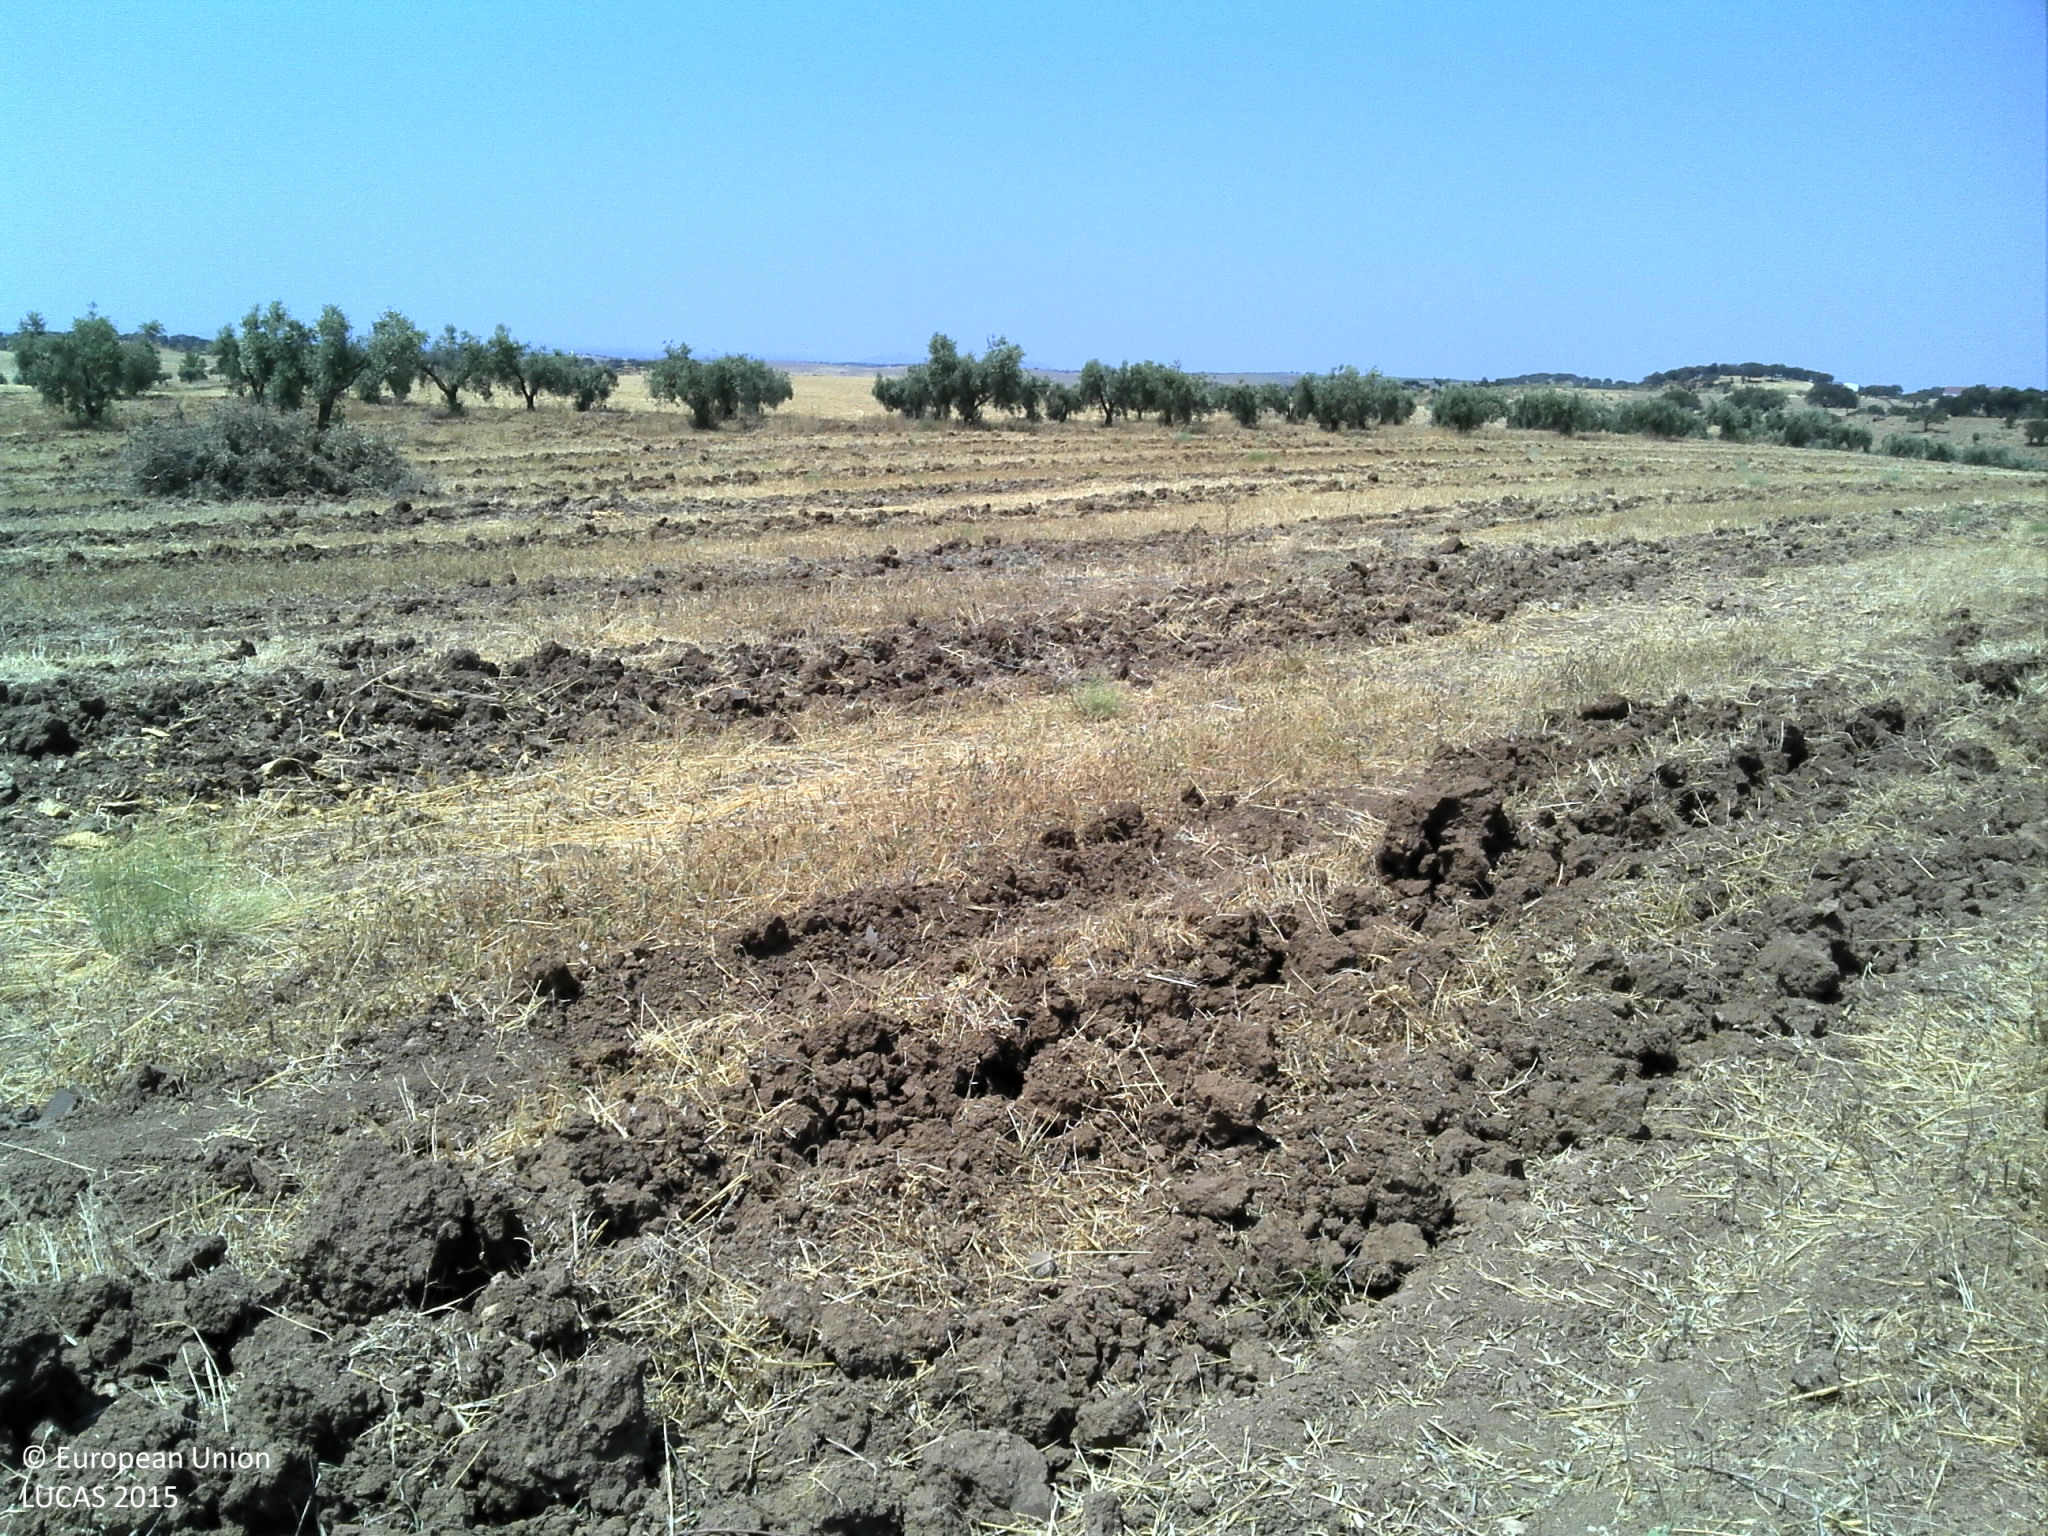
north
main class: Grassland
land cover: Grassland without tree/shrub cover
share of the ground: 10 - 25 %
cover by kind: herbaceous plants 95 %, unconsolidated bare surface 5 %
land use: Agriculture (excluding fallow land and kitchen gardens)
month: June
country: PT
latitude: 38.2240
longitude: -7.3719
